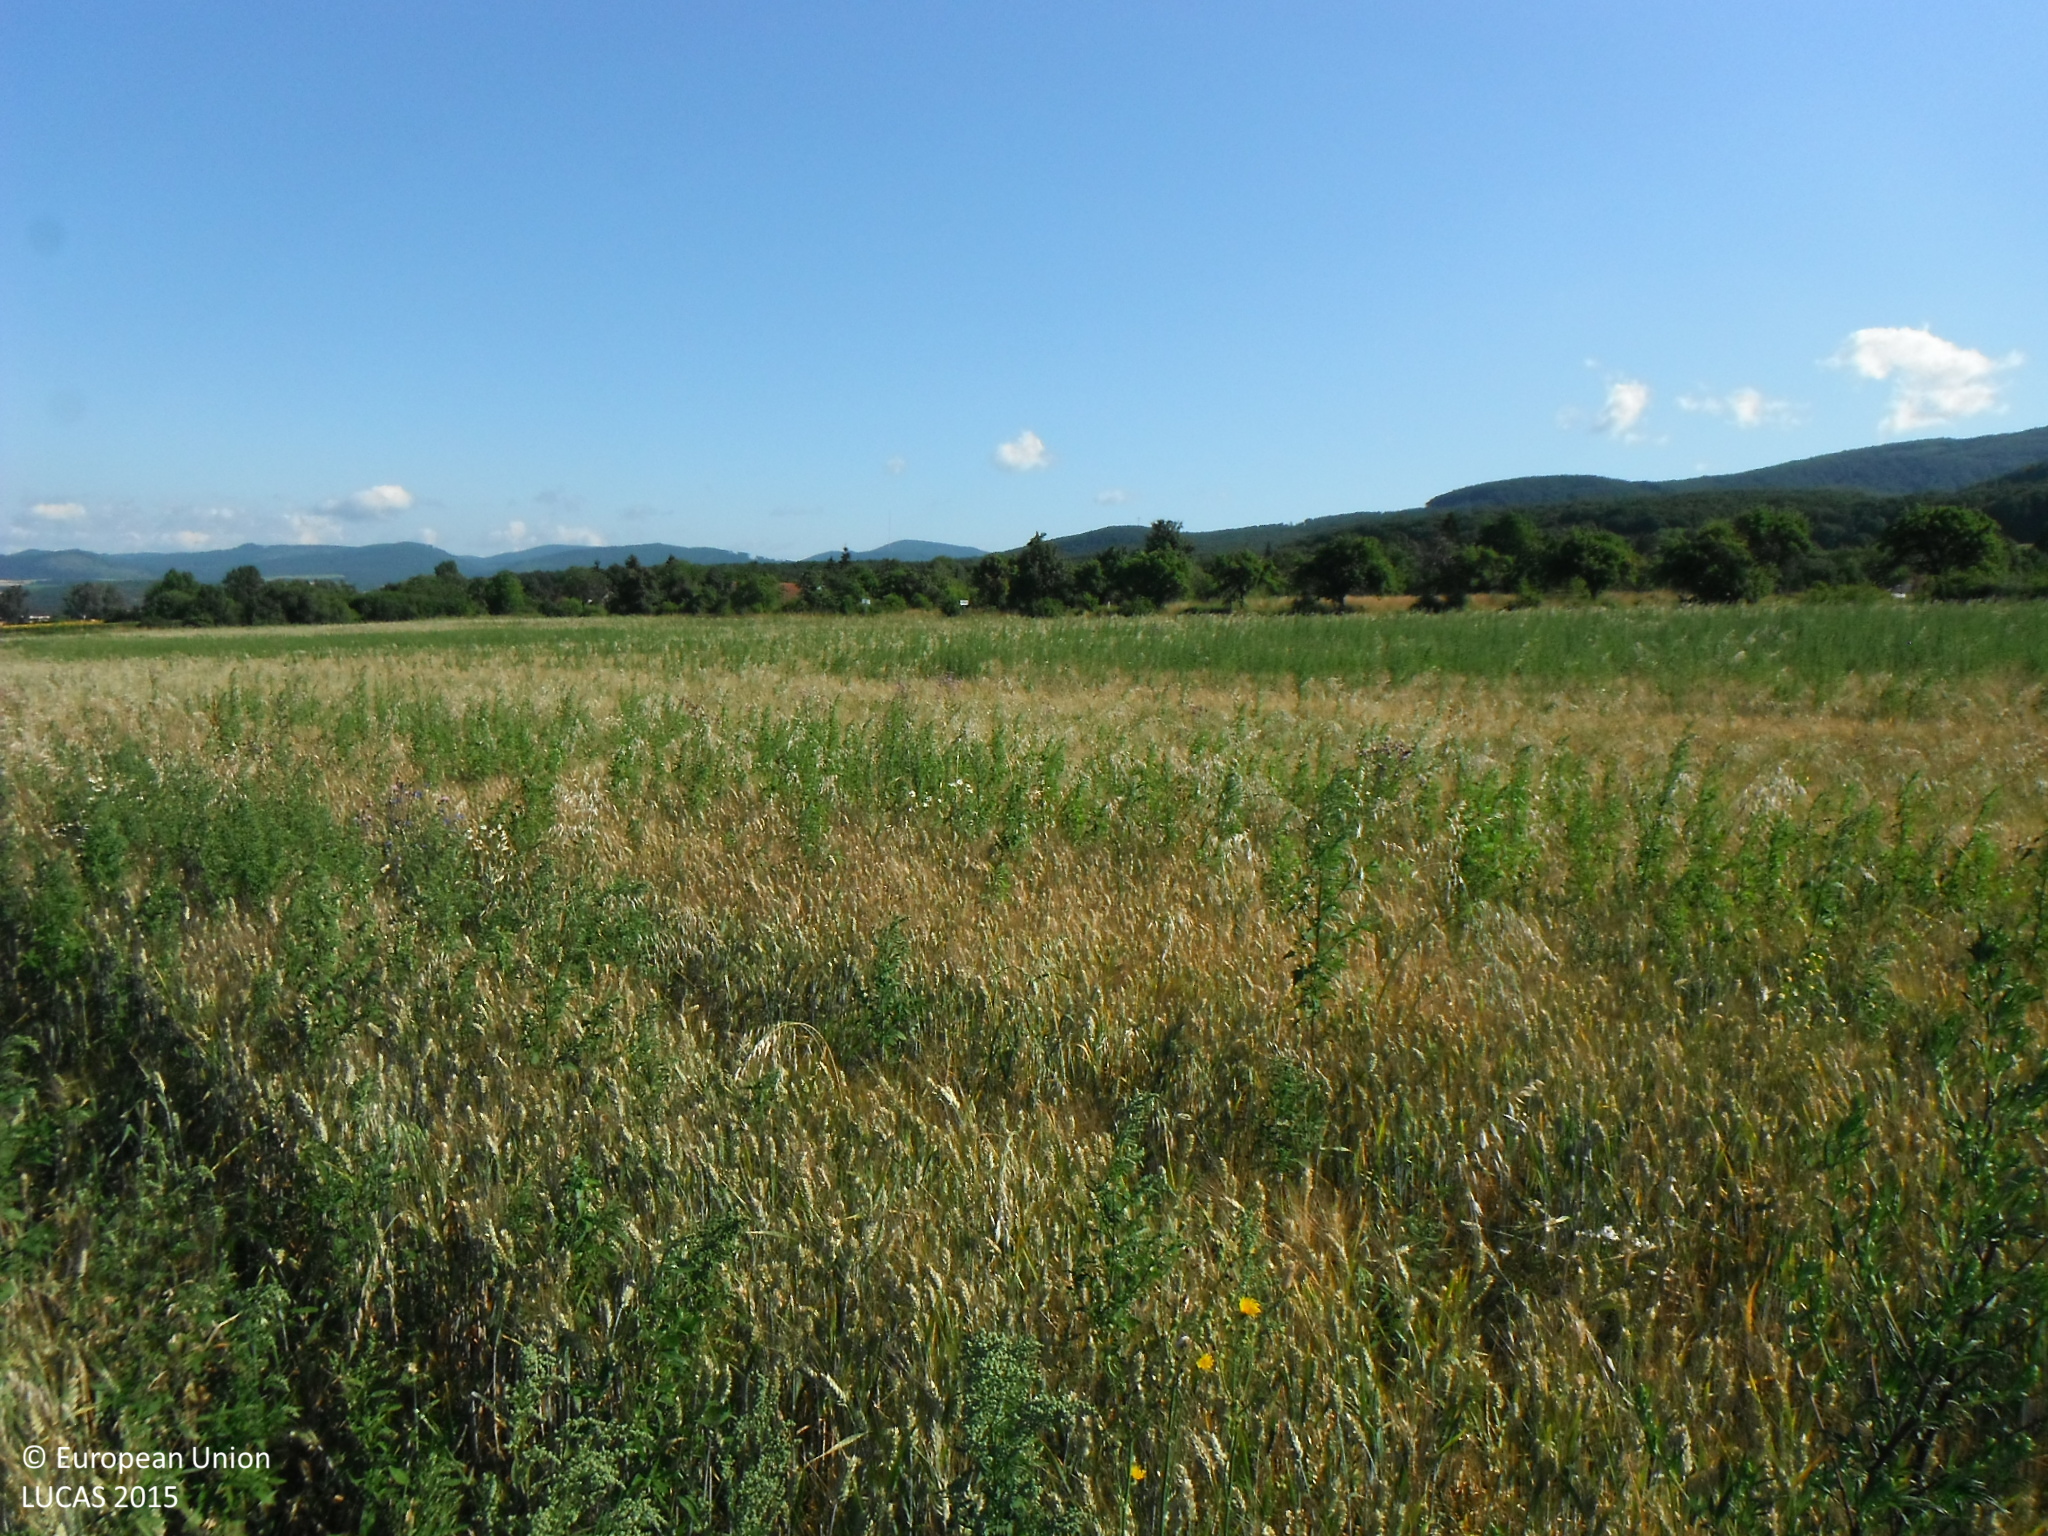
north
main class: Cropland
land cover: Durum wheat
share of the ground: > 75 %
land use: Agriculture (excluding fallow land and kitchen gardens)
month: July
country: SK
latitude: 48.8243
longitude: 21.4480
